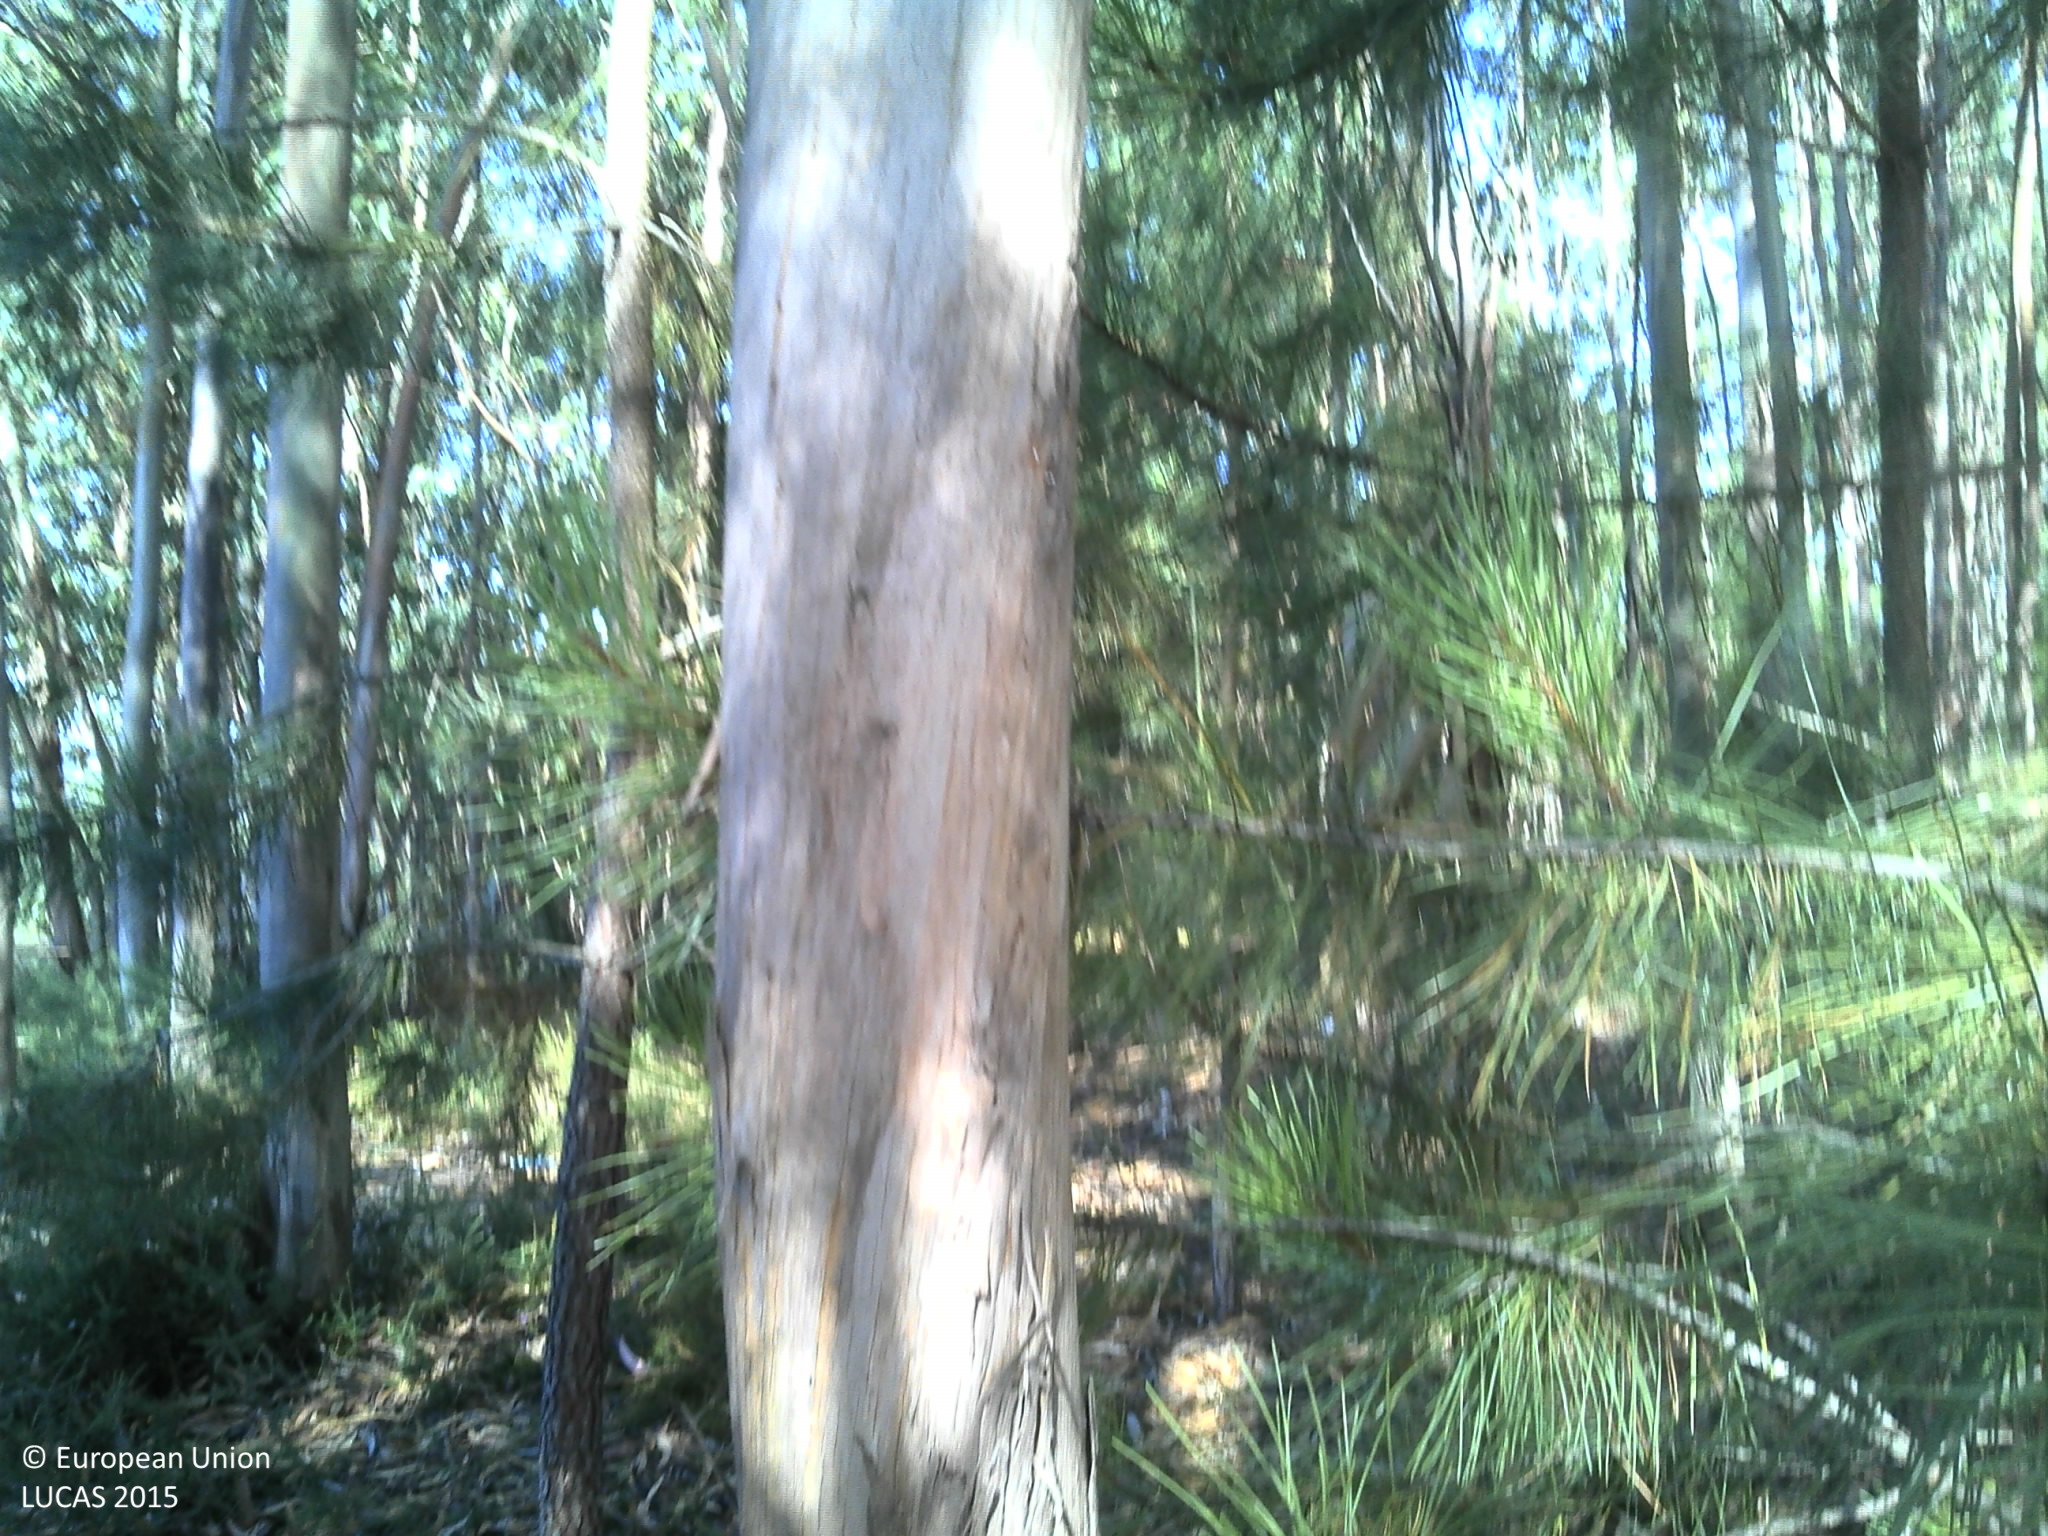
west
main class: Woodland
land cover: Broadleaved woodland
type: exotic forest
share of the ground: 50 - 75 %
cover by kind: broadleaved forest trees 70 %, unconsolidated bare surface 20 %, coniferous forest trees 5 %, shrubs 5 %
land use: Forestry
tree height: > 5 m
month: July
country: PT
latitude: 41.0424
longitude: -8.4053
